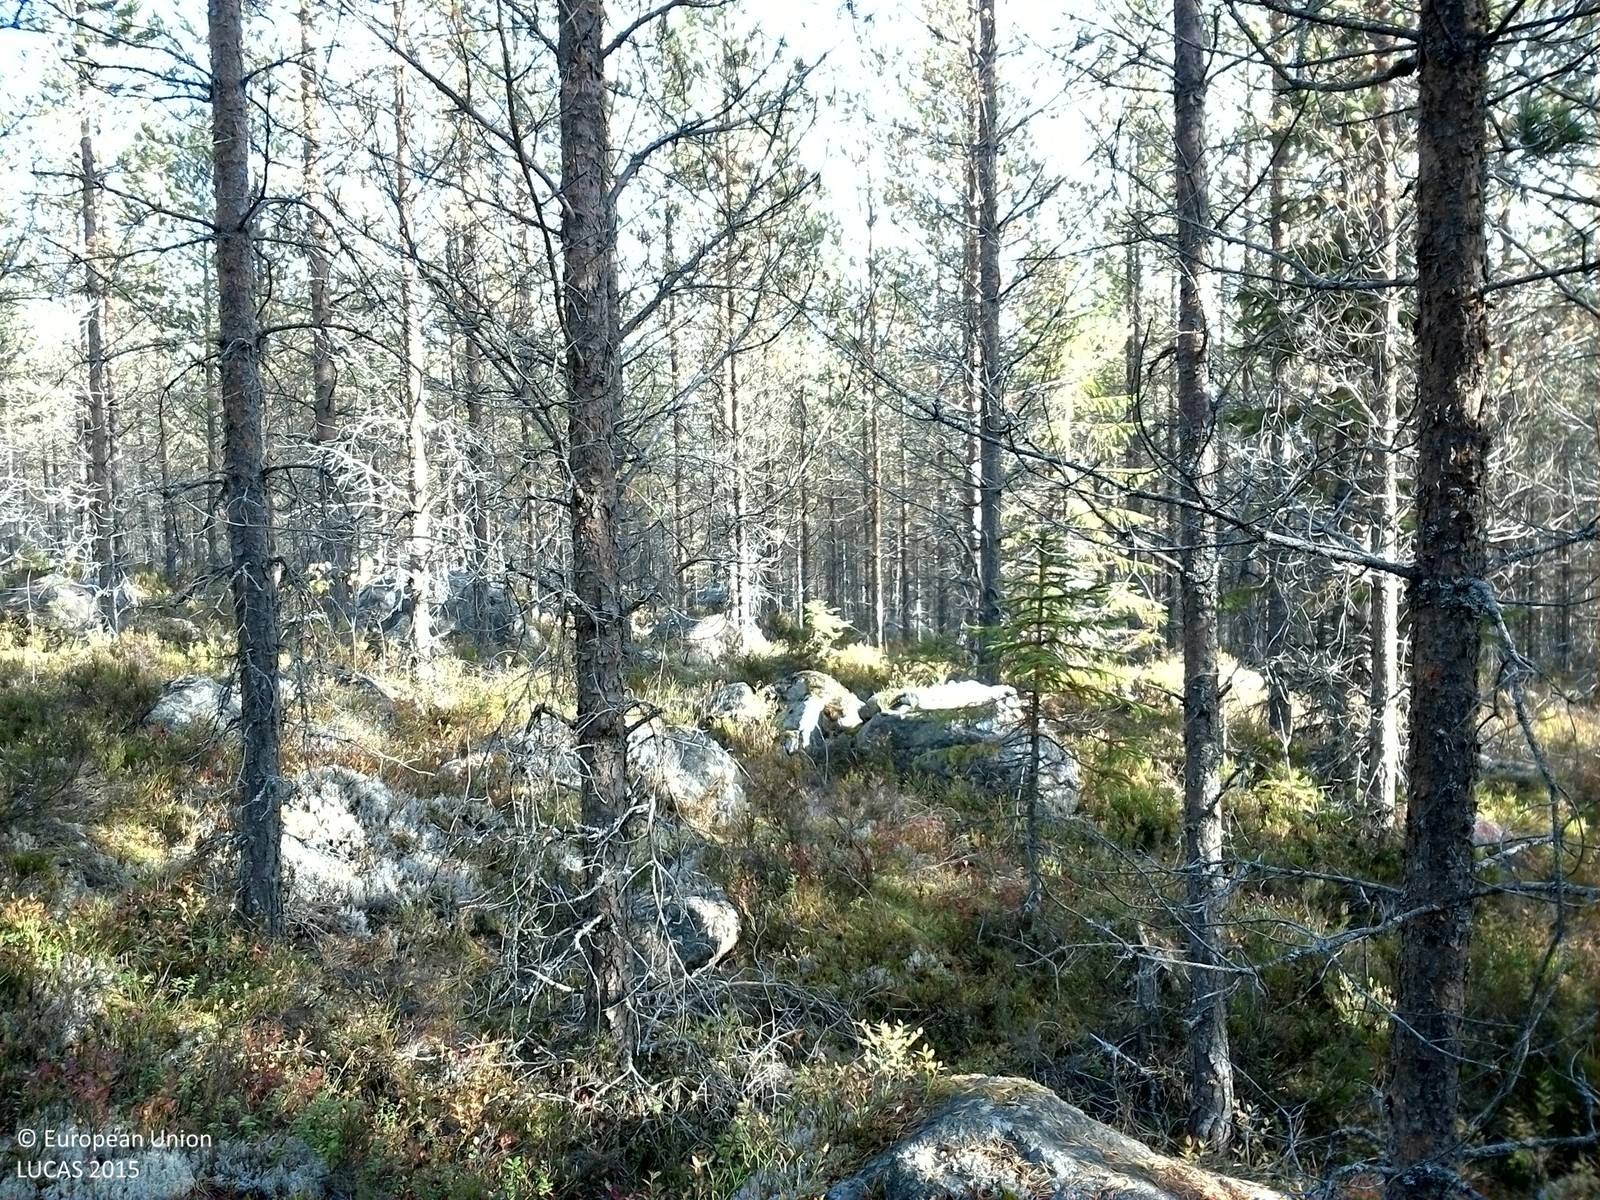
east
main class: Woodland
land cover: Pine dominated coniferous woodland
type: boreal forest
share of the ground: 50 - 75 %
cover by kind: coniferous forest trees 75 %, shrubs 15 %, lichens and mosses 5 %, consolidated bare surface 5 %
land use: Forestry
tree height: > 5 m
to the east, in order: Pine dominated coniferous woodland
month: October
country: SE
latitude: 61.4421
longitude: 15.1037
